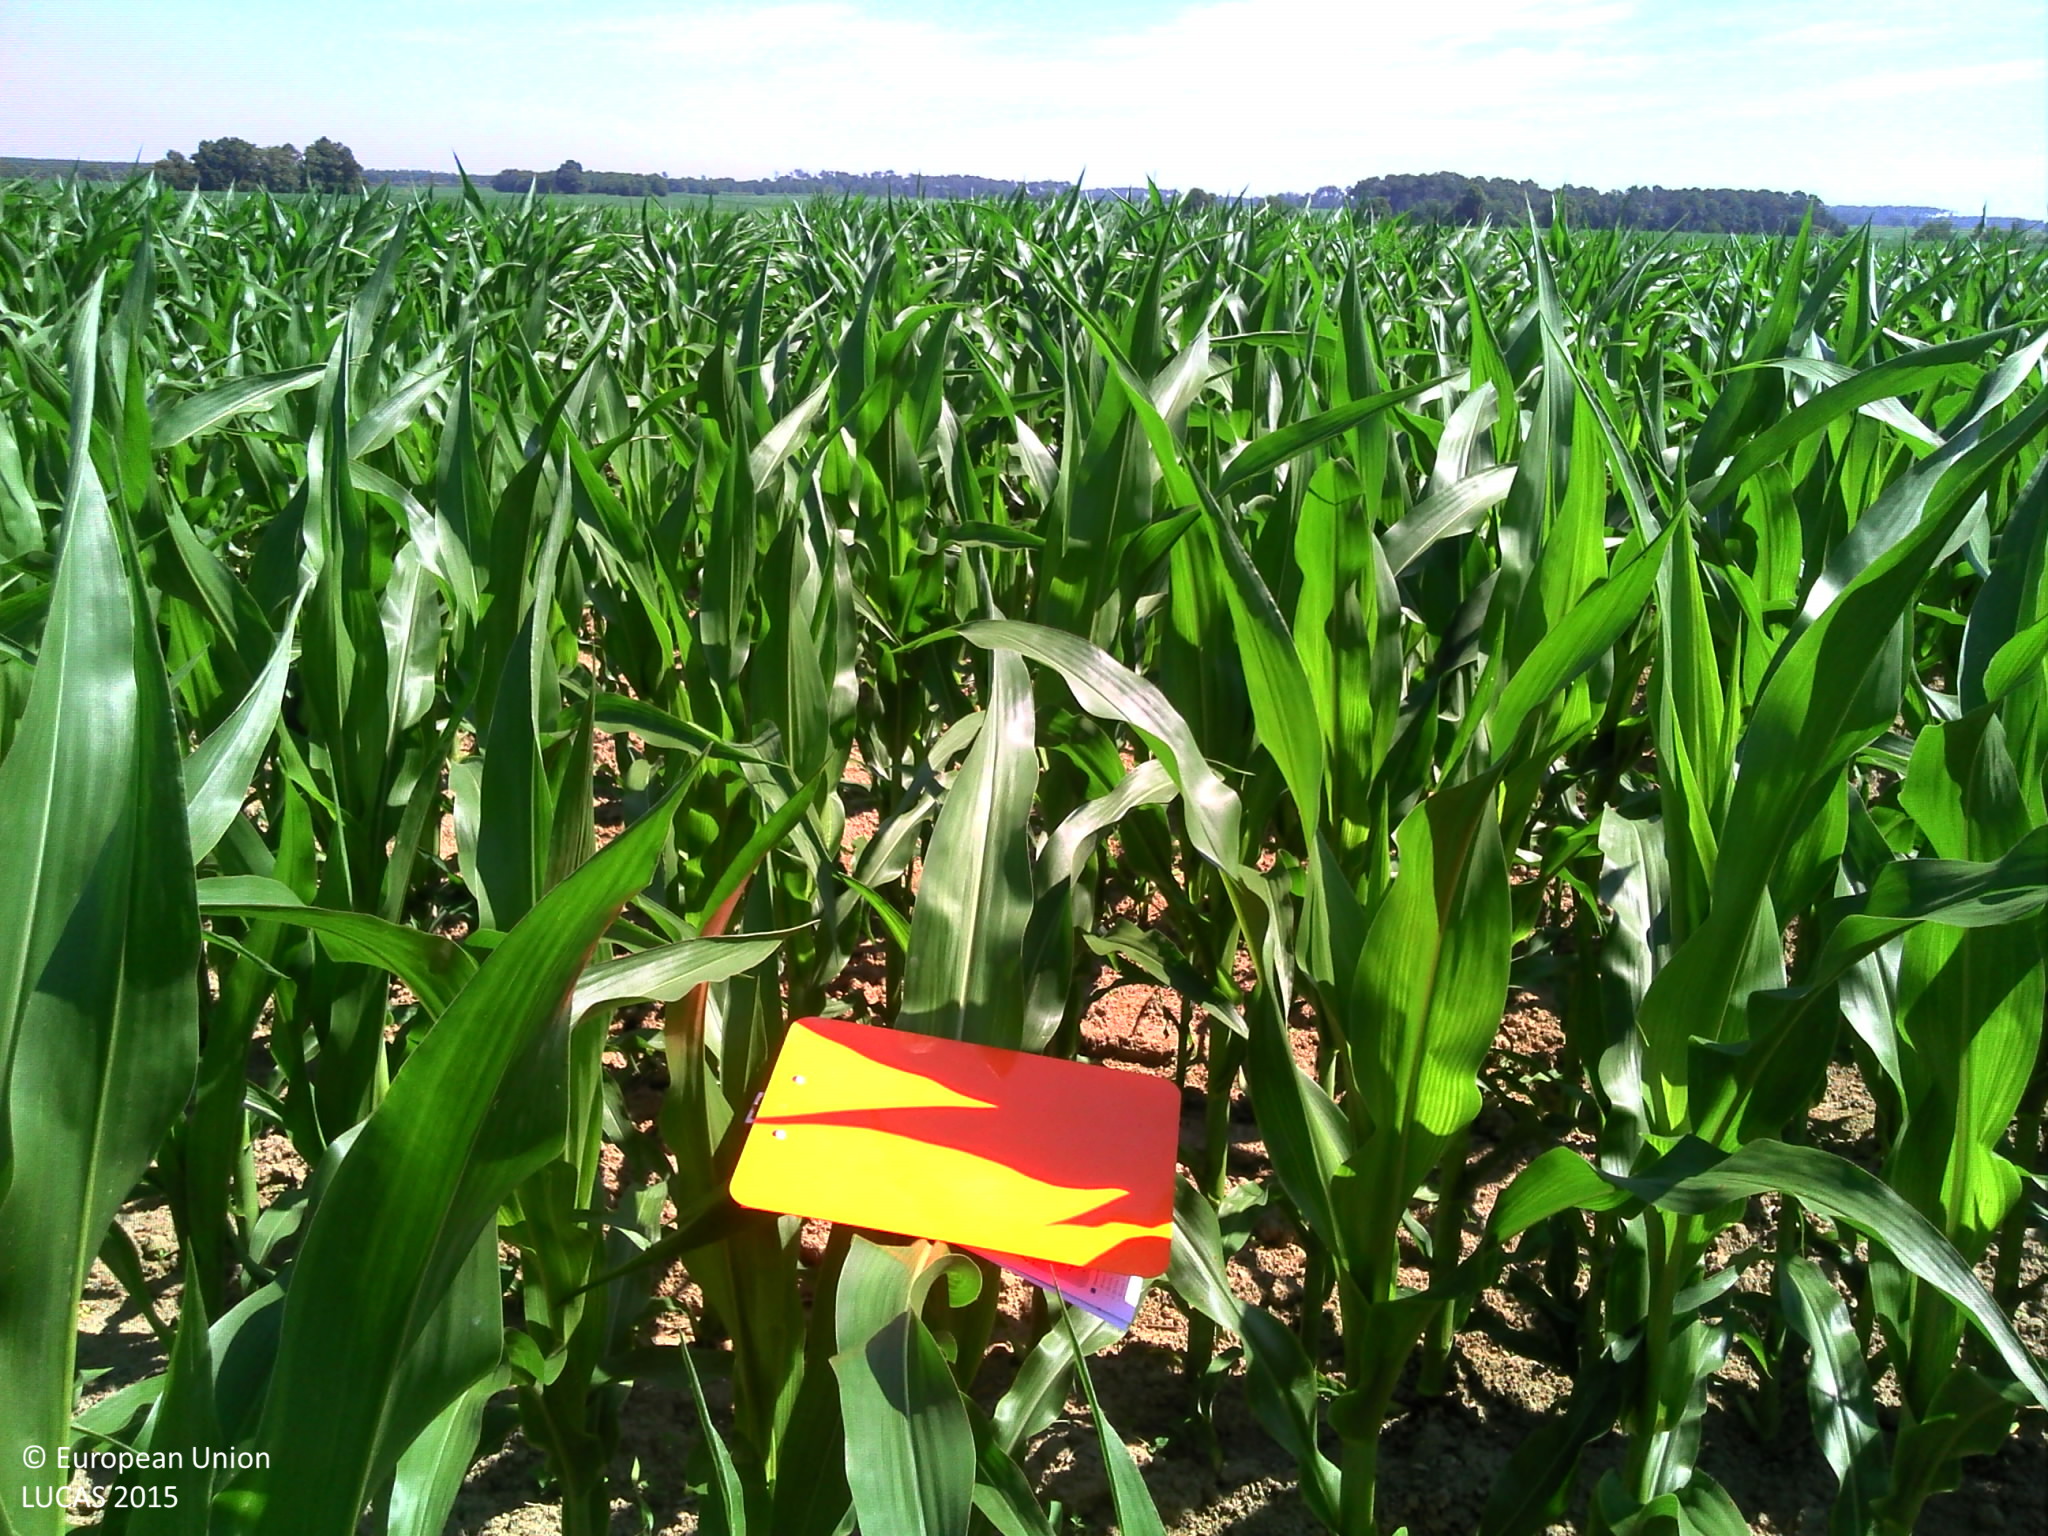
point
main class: Cropland
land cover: Maize
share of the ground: > 75 %
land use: Agriculture (excluding fallow land and kitchen gardens)
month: June
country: FR
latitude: 43.6108
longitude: -0.5545
